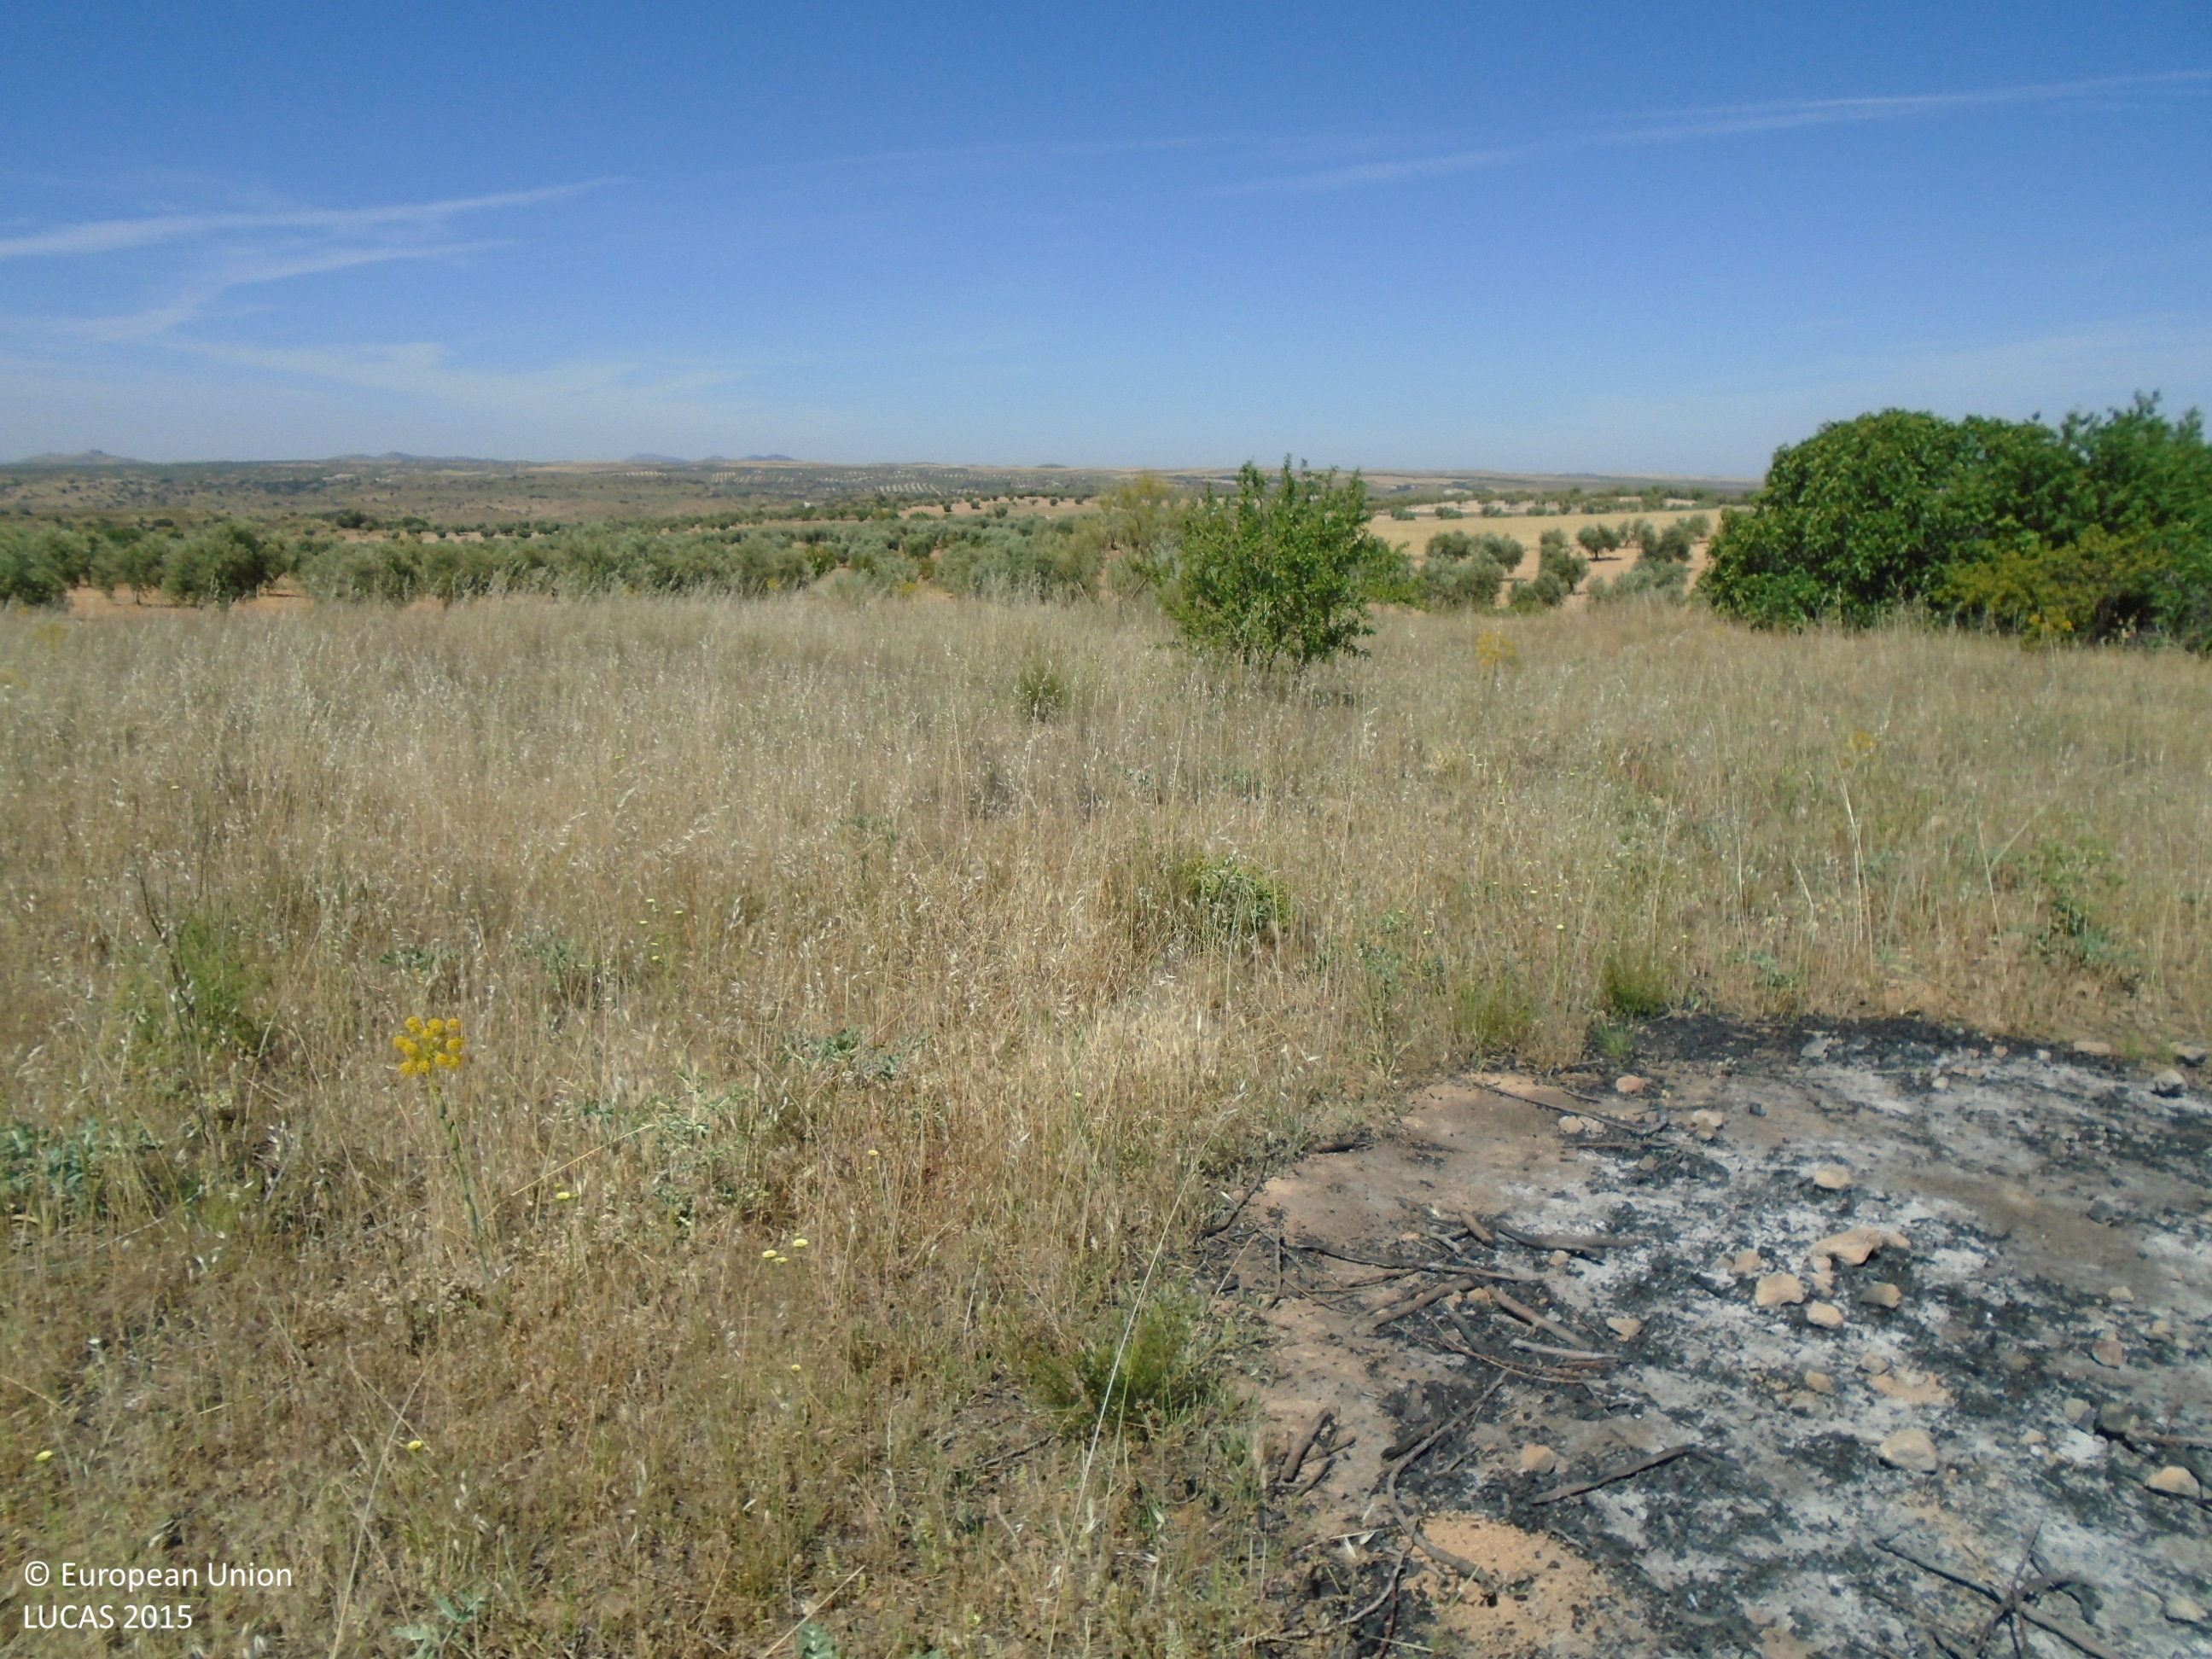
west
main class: Grassland
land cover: Grassland without tree/shrub cover
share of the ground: > 75 %
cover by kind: herbaceous plants 95 %, shrubs 5 %
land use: Abandoned areas
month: May
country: ES
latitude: 39.8098
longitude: -3.7315
